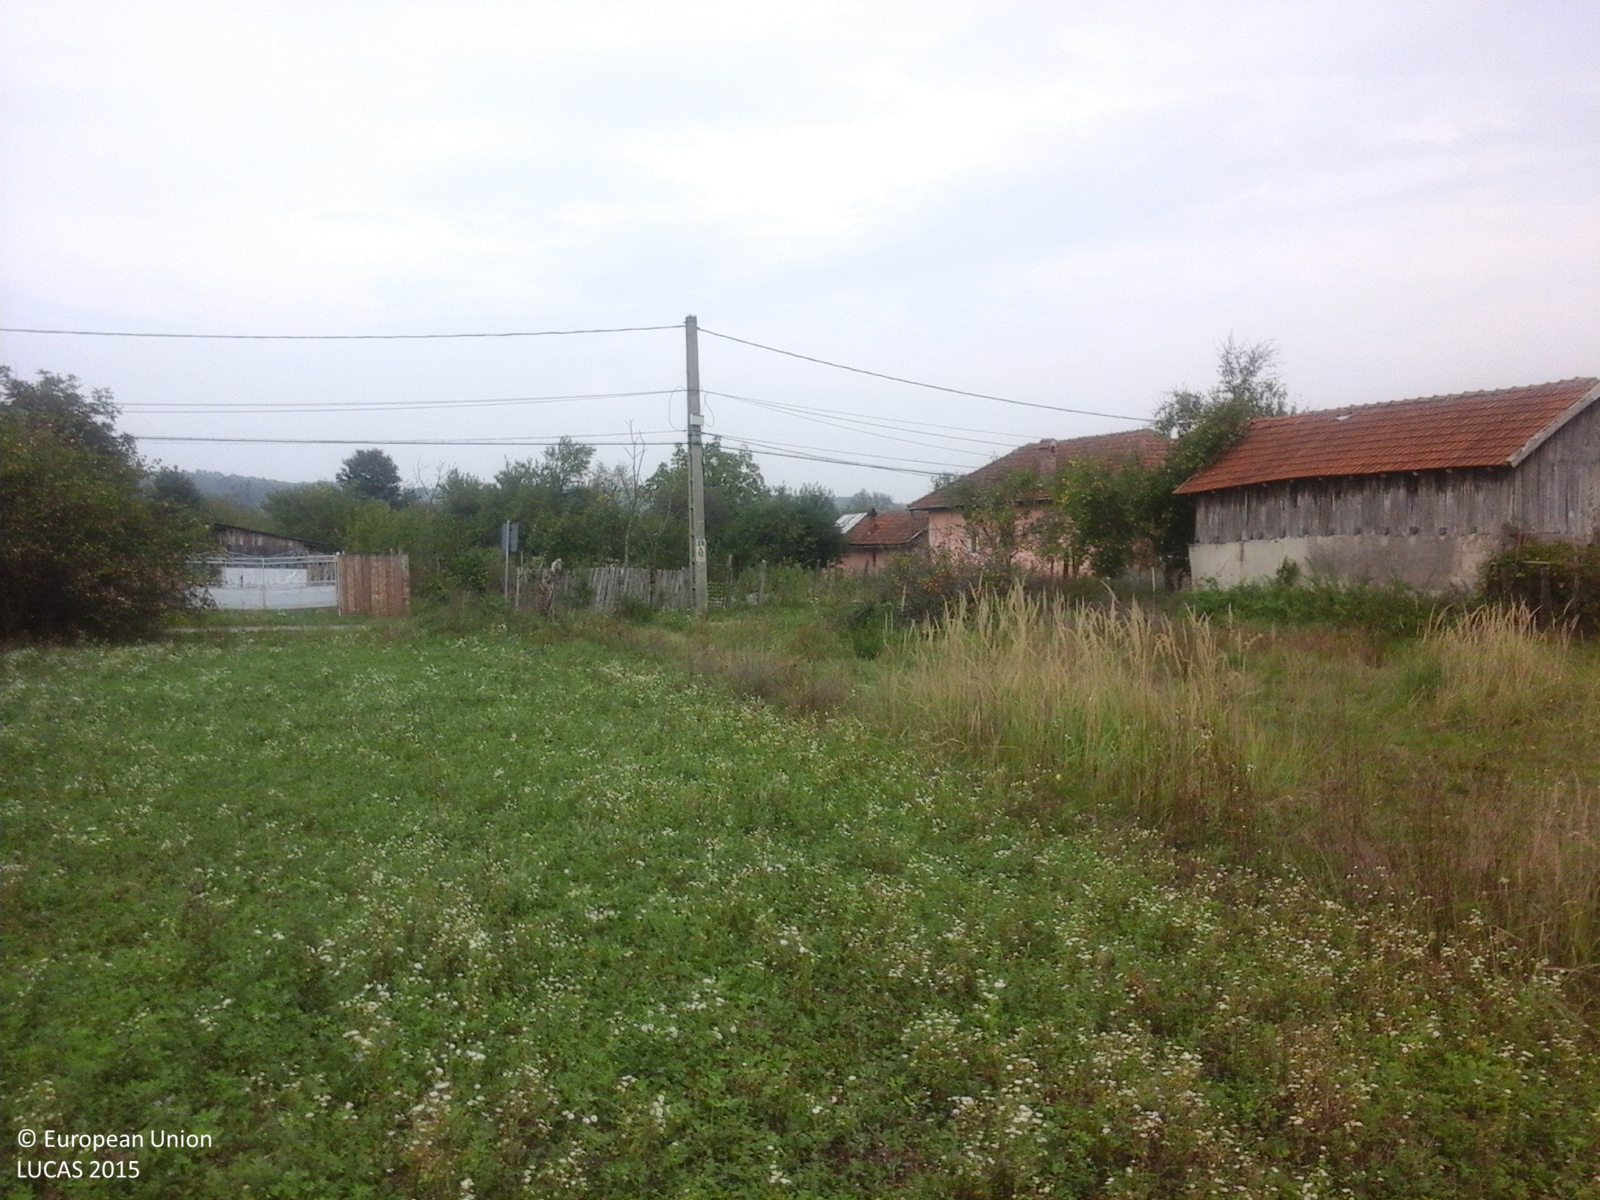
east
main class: Cropland
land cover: Lucerne
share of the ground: > 75 %
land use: Agriculture (excluding fallow land and kitchen gardens)
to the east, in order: Lucerne; Grassland with sparse tree/shrub cover; Paved roads, cycling and walking lanes; Grass margins; Electric lines; Fences; Vineyards; Other fruit trees and berries; Broadleaved woodland; Arable land (only in case pi); Tracks; Arable land (only in case pi)
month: September
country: RO
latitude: 45.0438
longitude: 23.1409
